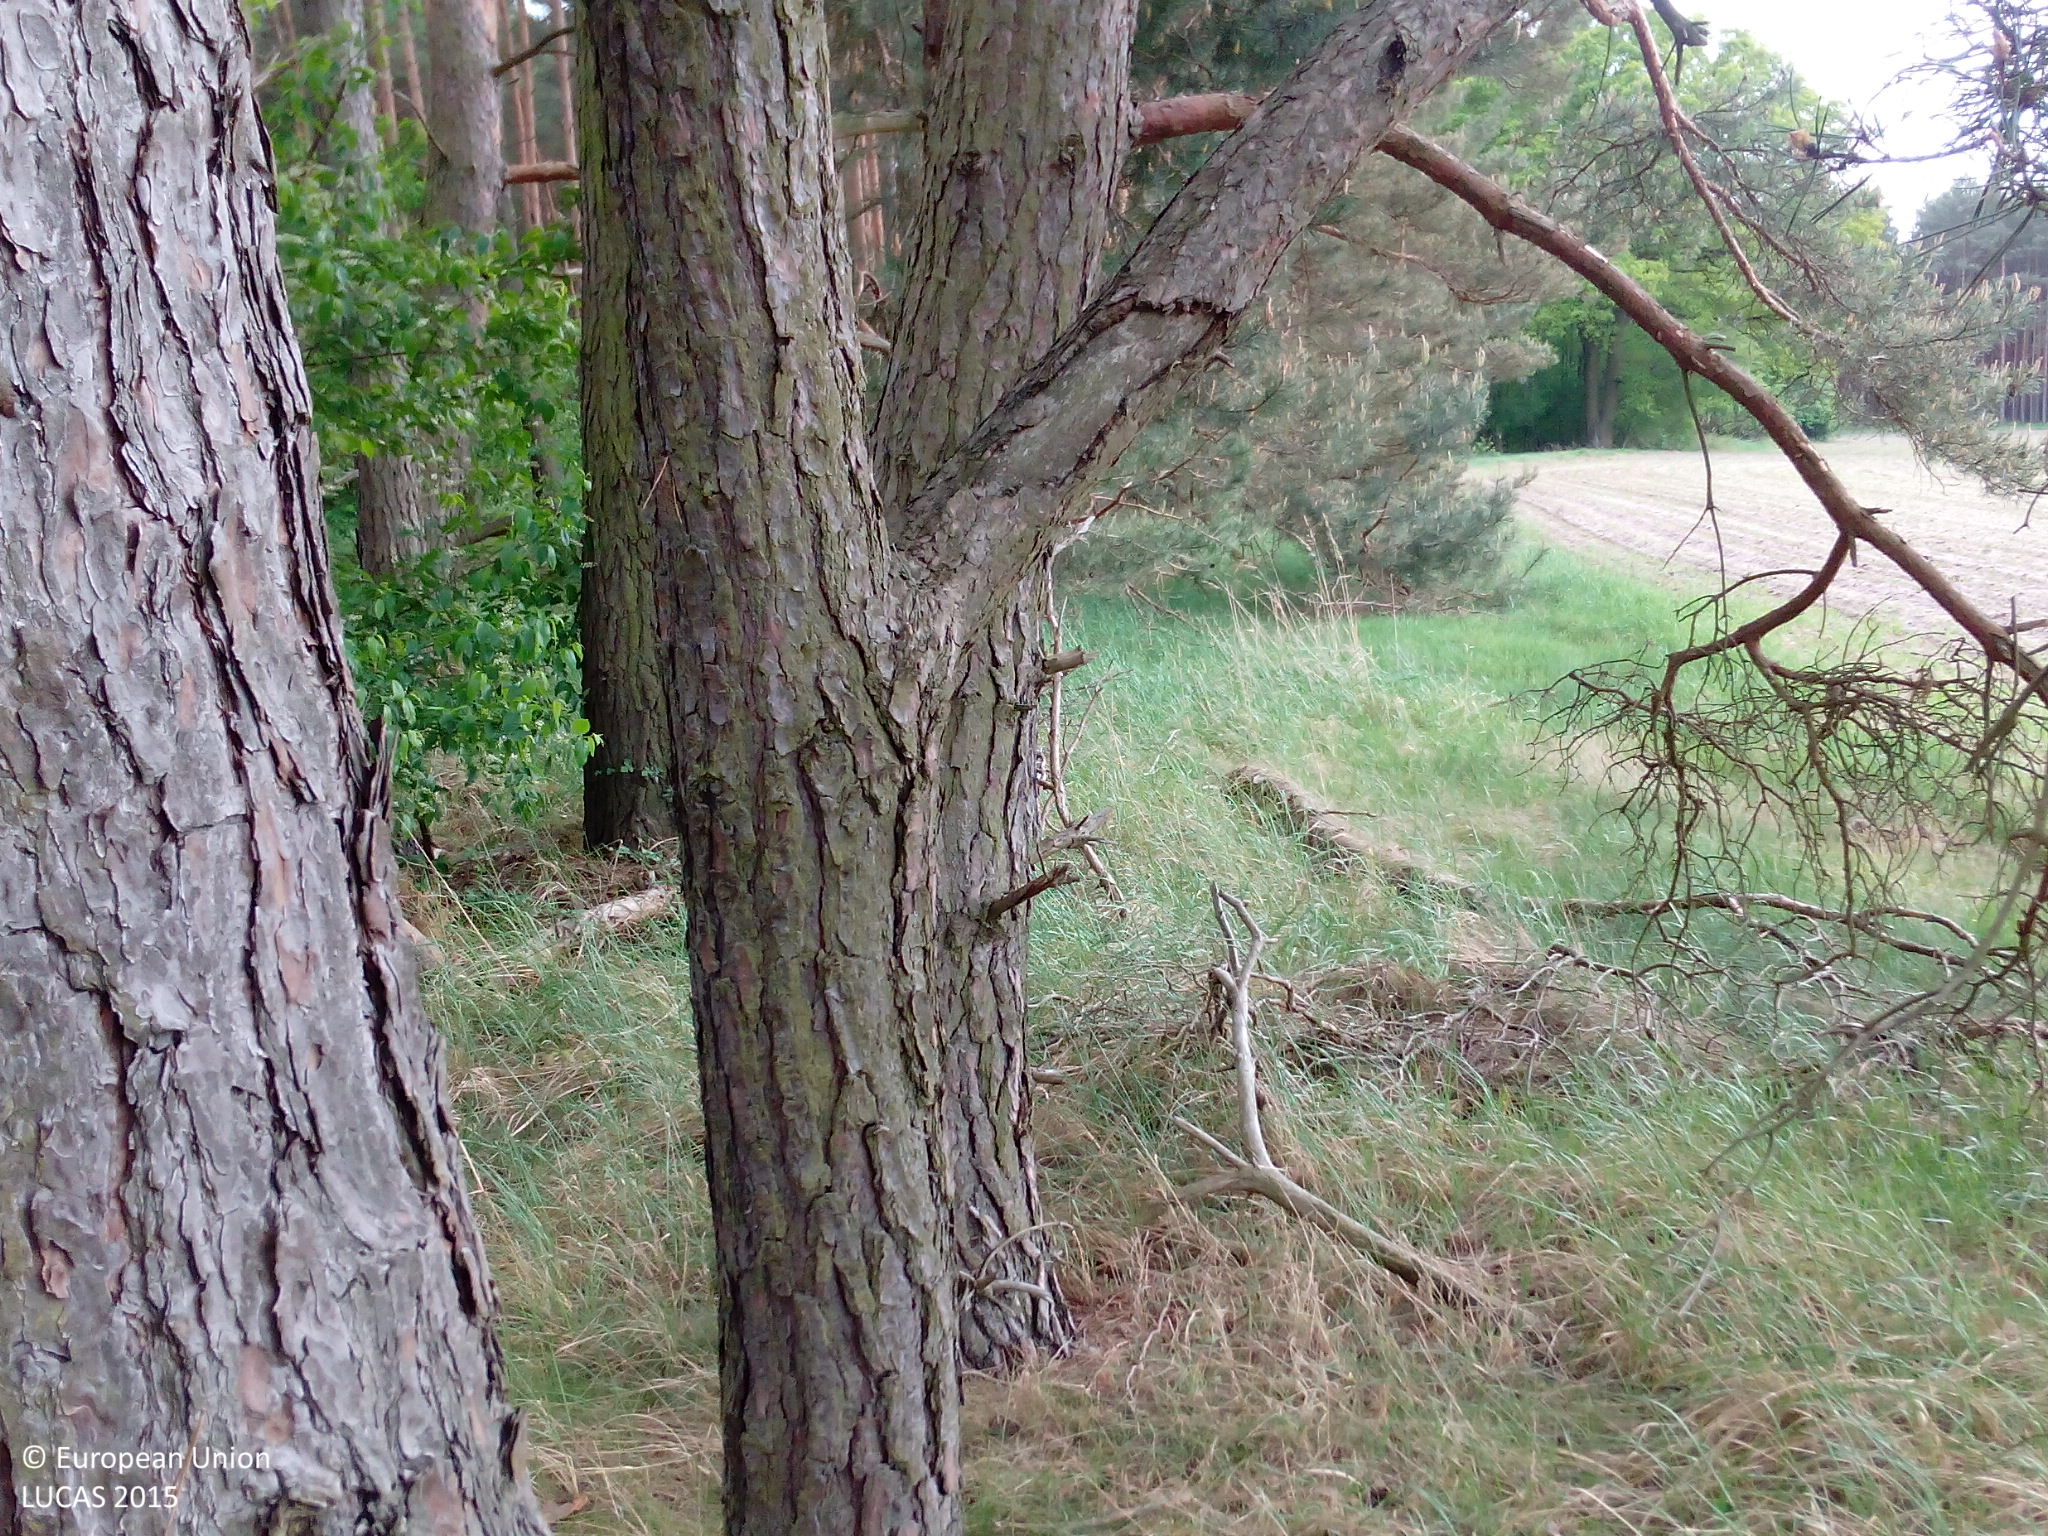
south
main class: Woodland
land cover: Pine dominated coniferous woodland
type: hemiboreal forest and nemoral coniferous forest and mixed broadleaved-coniferous forest
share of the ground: > 75 %
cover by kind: coniferous forest trees 80 %, herbaceous plants 15 %, unconsolidated bare surface 5 %
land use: Forestry
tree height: > 5 m
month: May
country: DE
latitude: 52.1732
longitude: 13.1731
